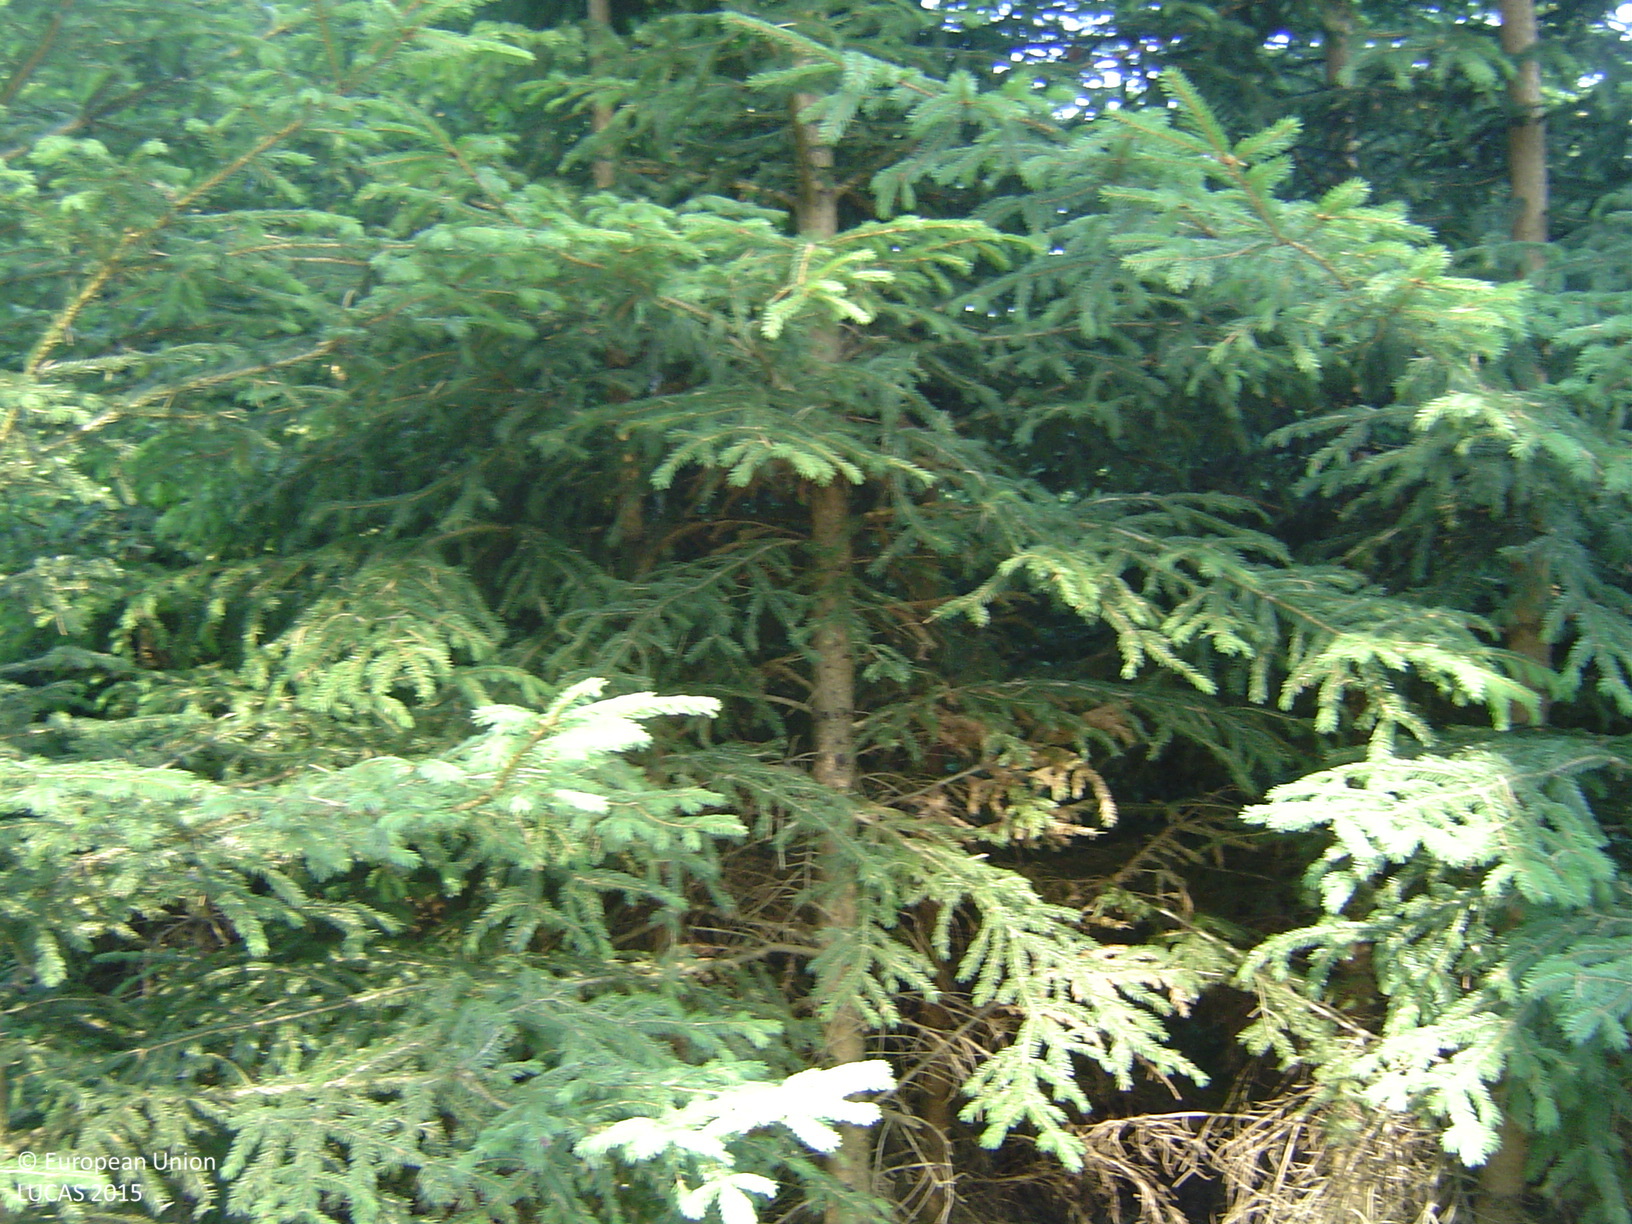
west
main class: Woodland
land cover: Spruce dominated coniferous woodland
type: hemiboreal forest and nemoral coniferous forest and mixed broadleaved-coniferous forest
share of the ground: > 75 %
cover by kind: coniferous forest trees 100 %
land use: Forestry
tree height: > 5 m
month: August
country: CZ
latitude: 49.6706
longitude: 14.3105
